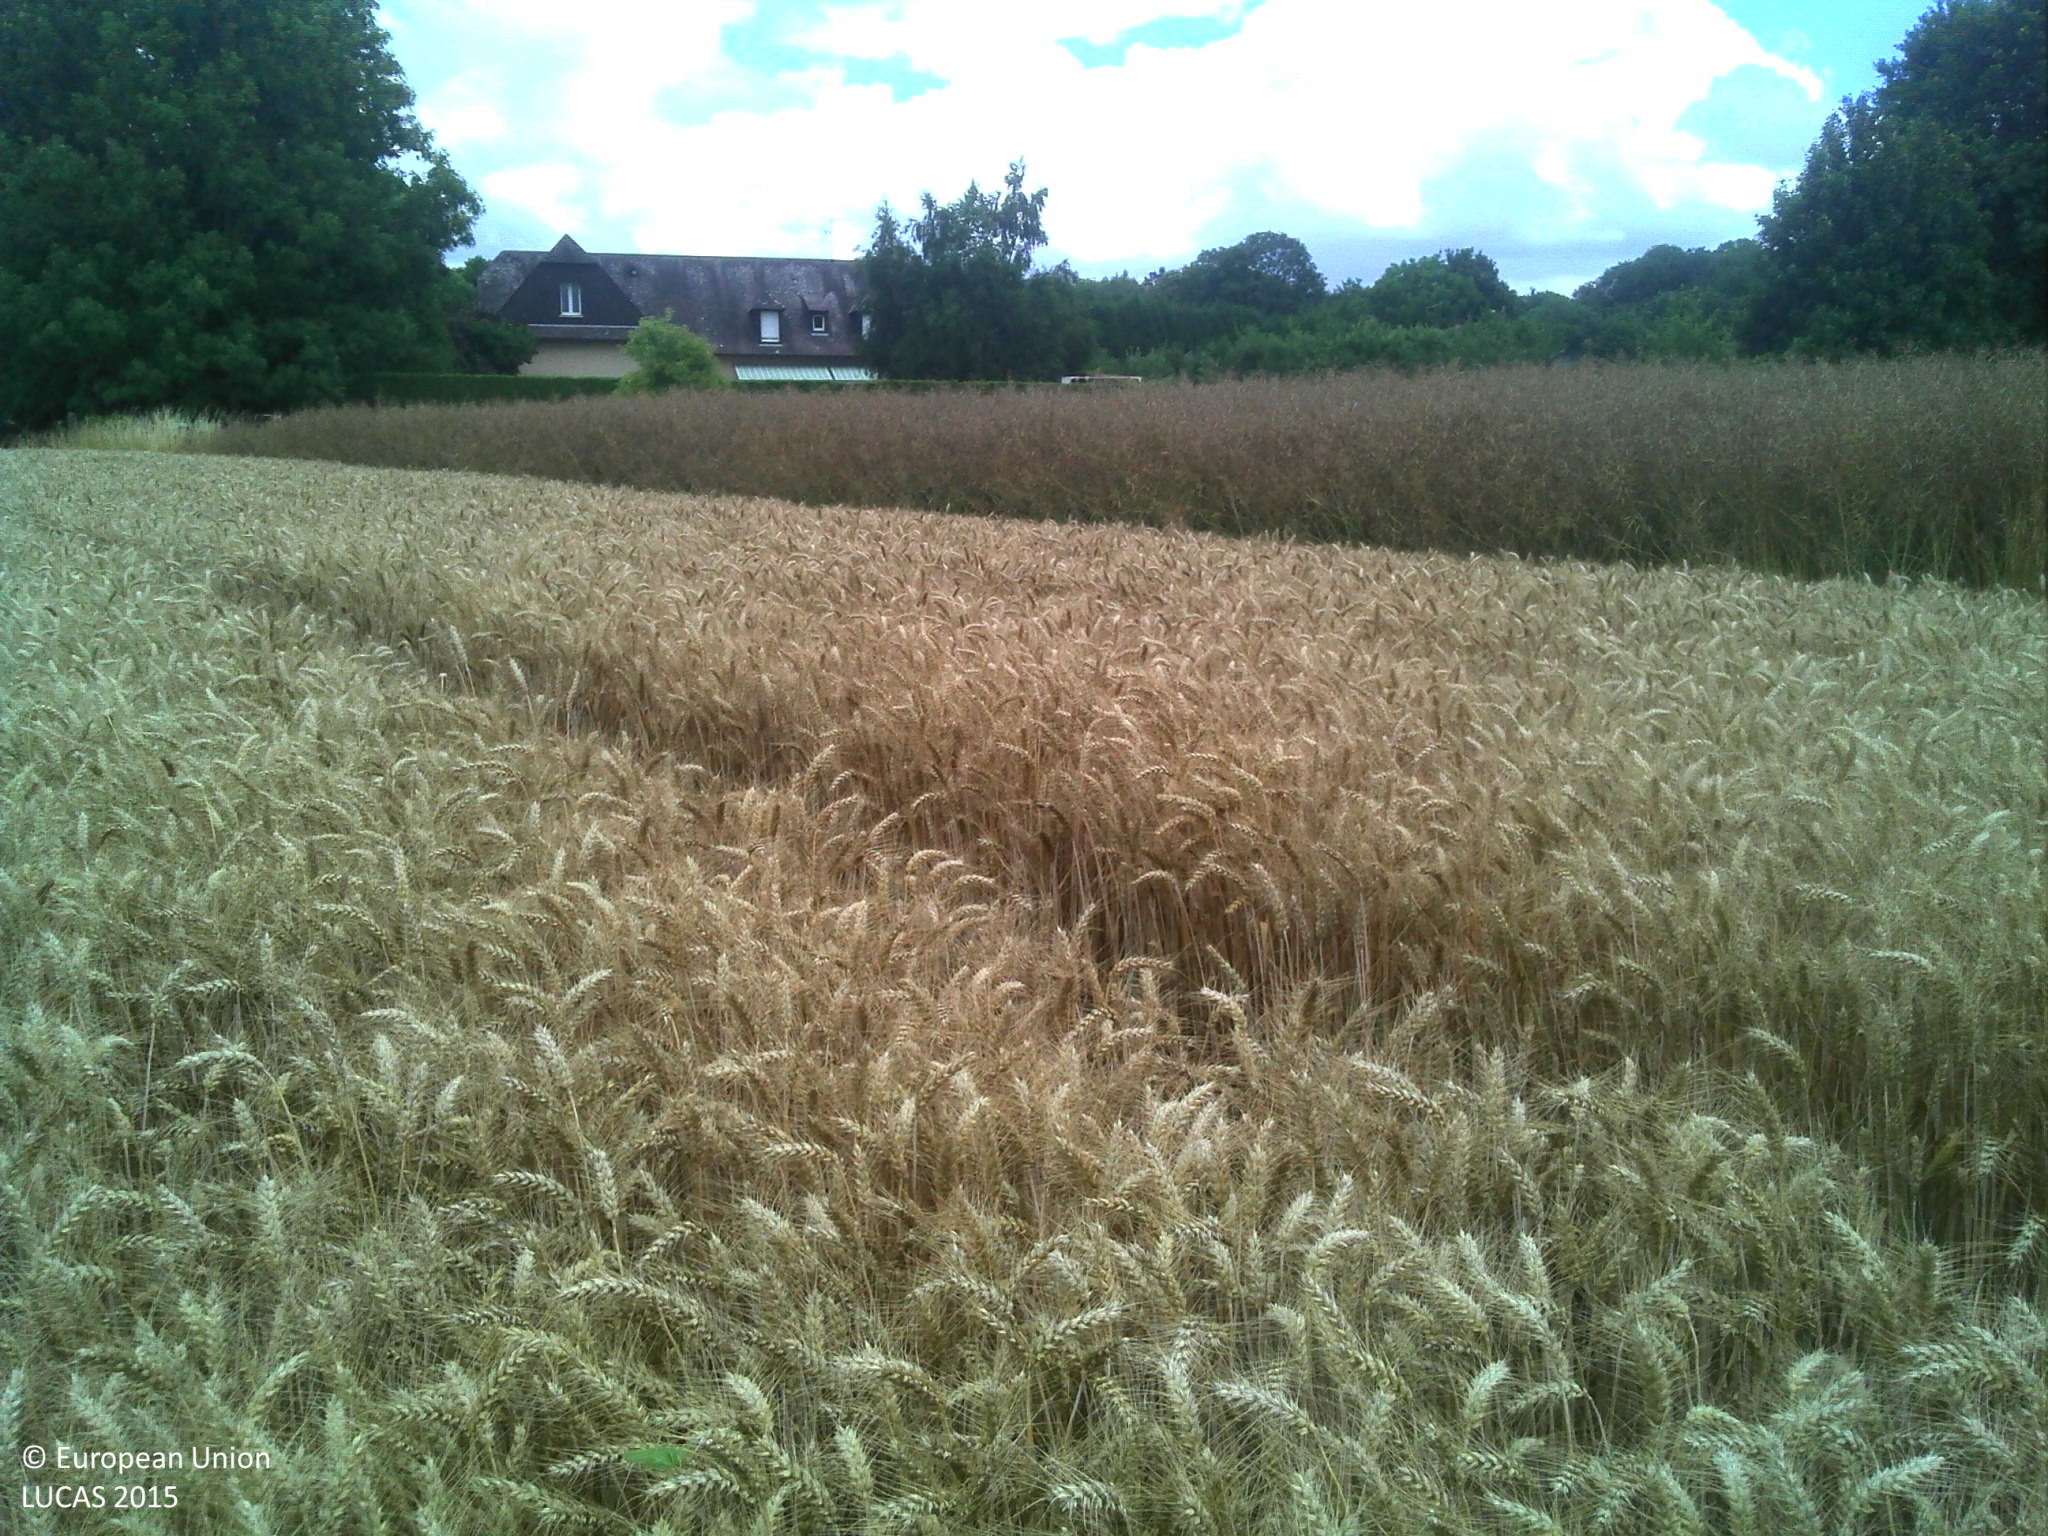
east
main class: Cropland
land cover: Common wheat
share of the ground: > 75 %
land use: Agriculture (excluding fallow land and kitchen gardens)
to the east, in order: Common wheat; Rape and turnip rape; Fences; Grassland without tree/shrub cover; Fences; Grass margins; Managed hedges; Artificial constructions in urban areas; Broadleaved woodland
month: July
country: FR
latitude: 49.8263
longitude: 3.6404
